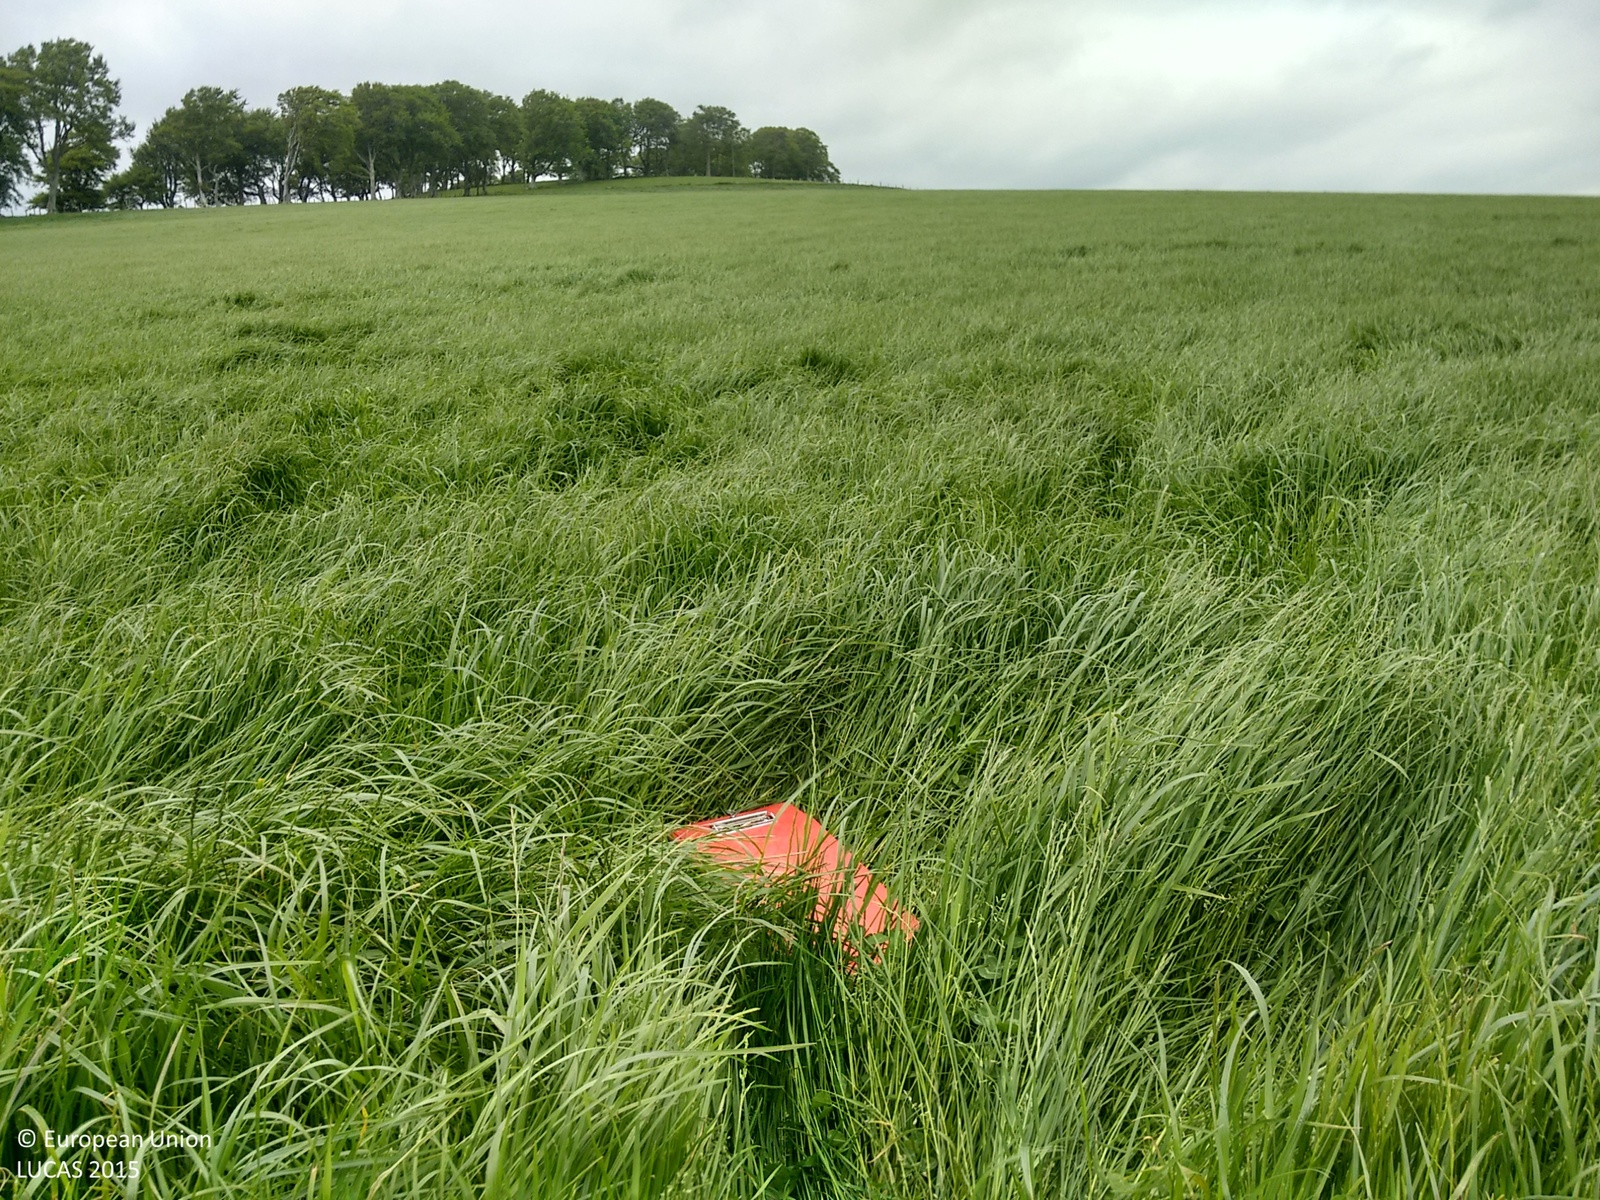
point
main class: Grassland
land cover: Grassland without tree/shrub cover
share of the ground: > 75 %
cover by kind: herbaceous plants 100 %
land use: Agriculture (excluding fallow land and kitchen gardens)
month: June
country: GB
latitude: 55.6349
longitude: -3.6635
